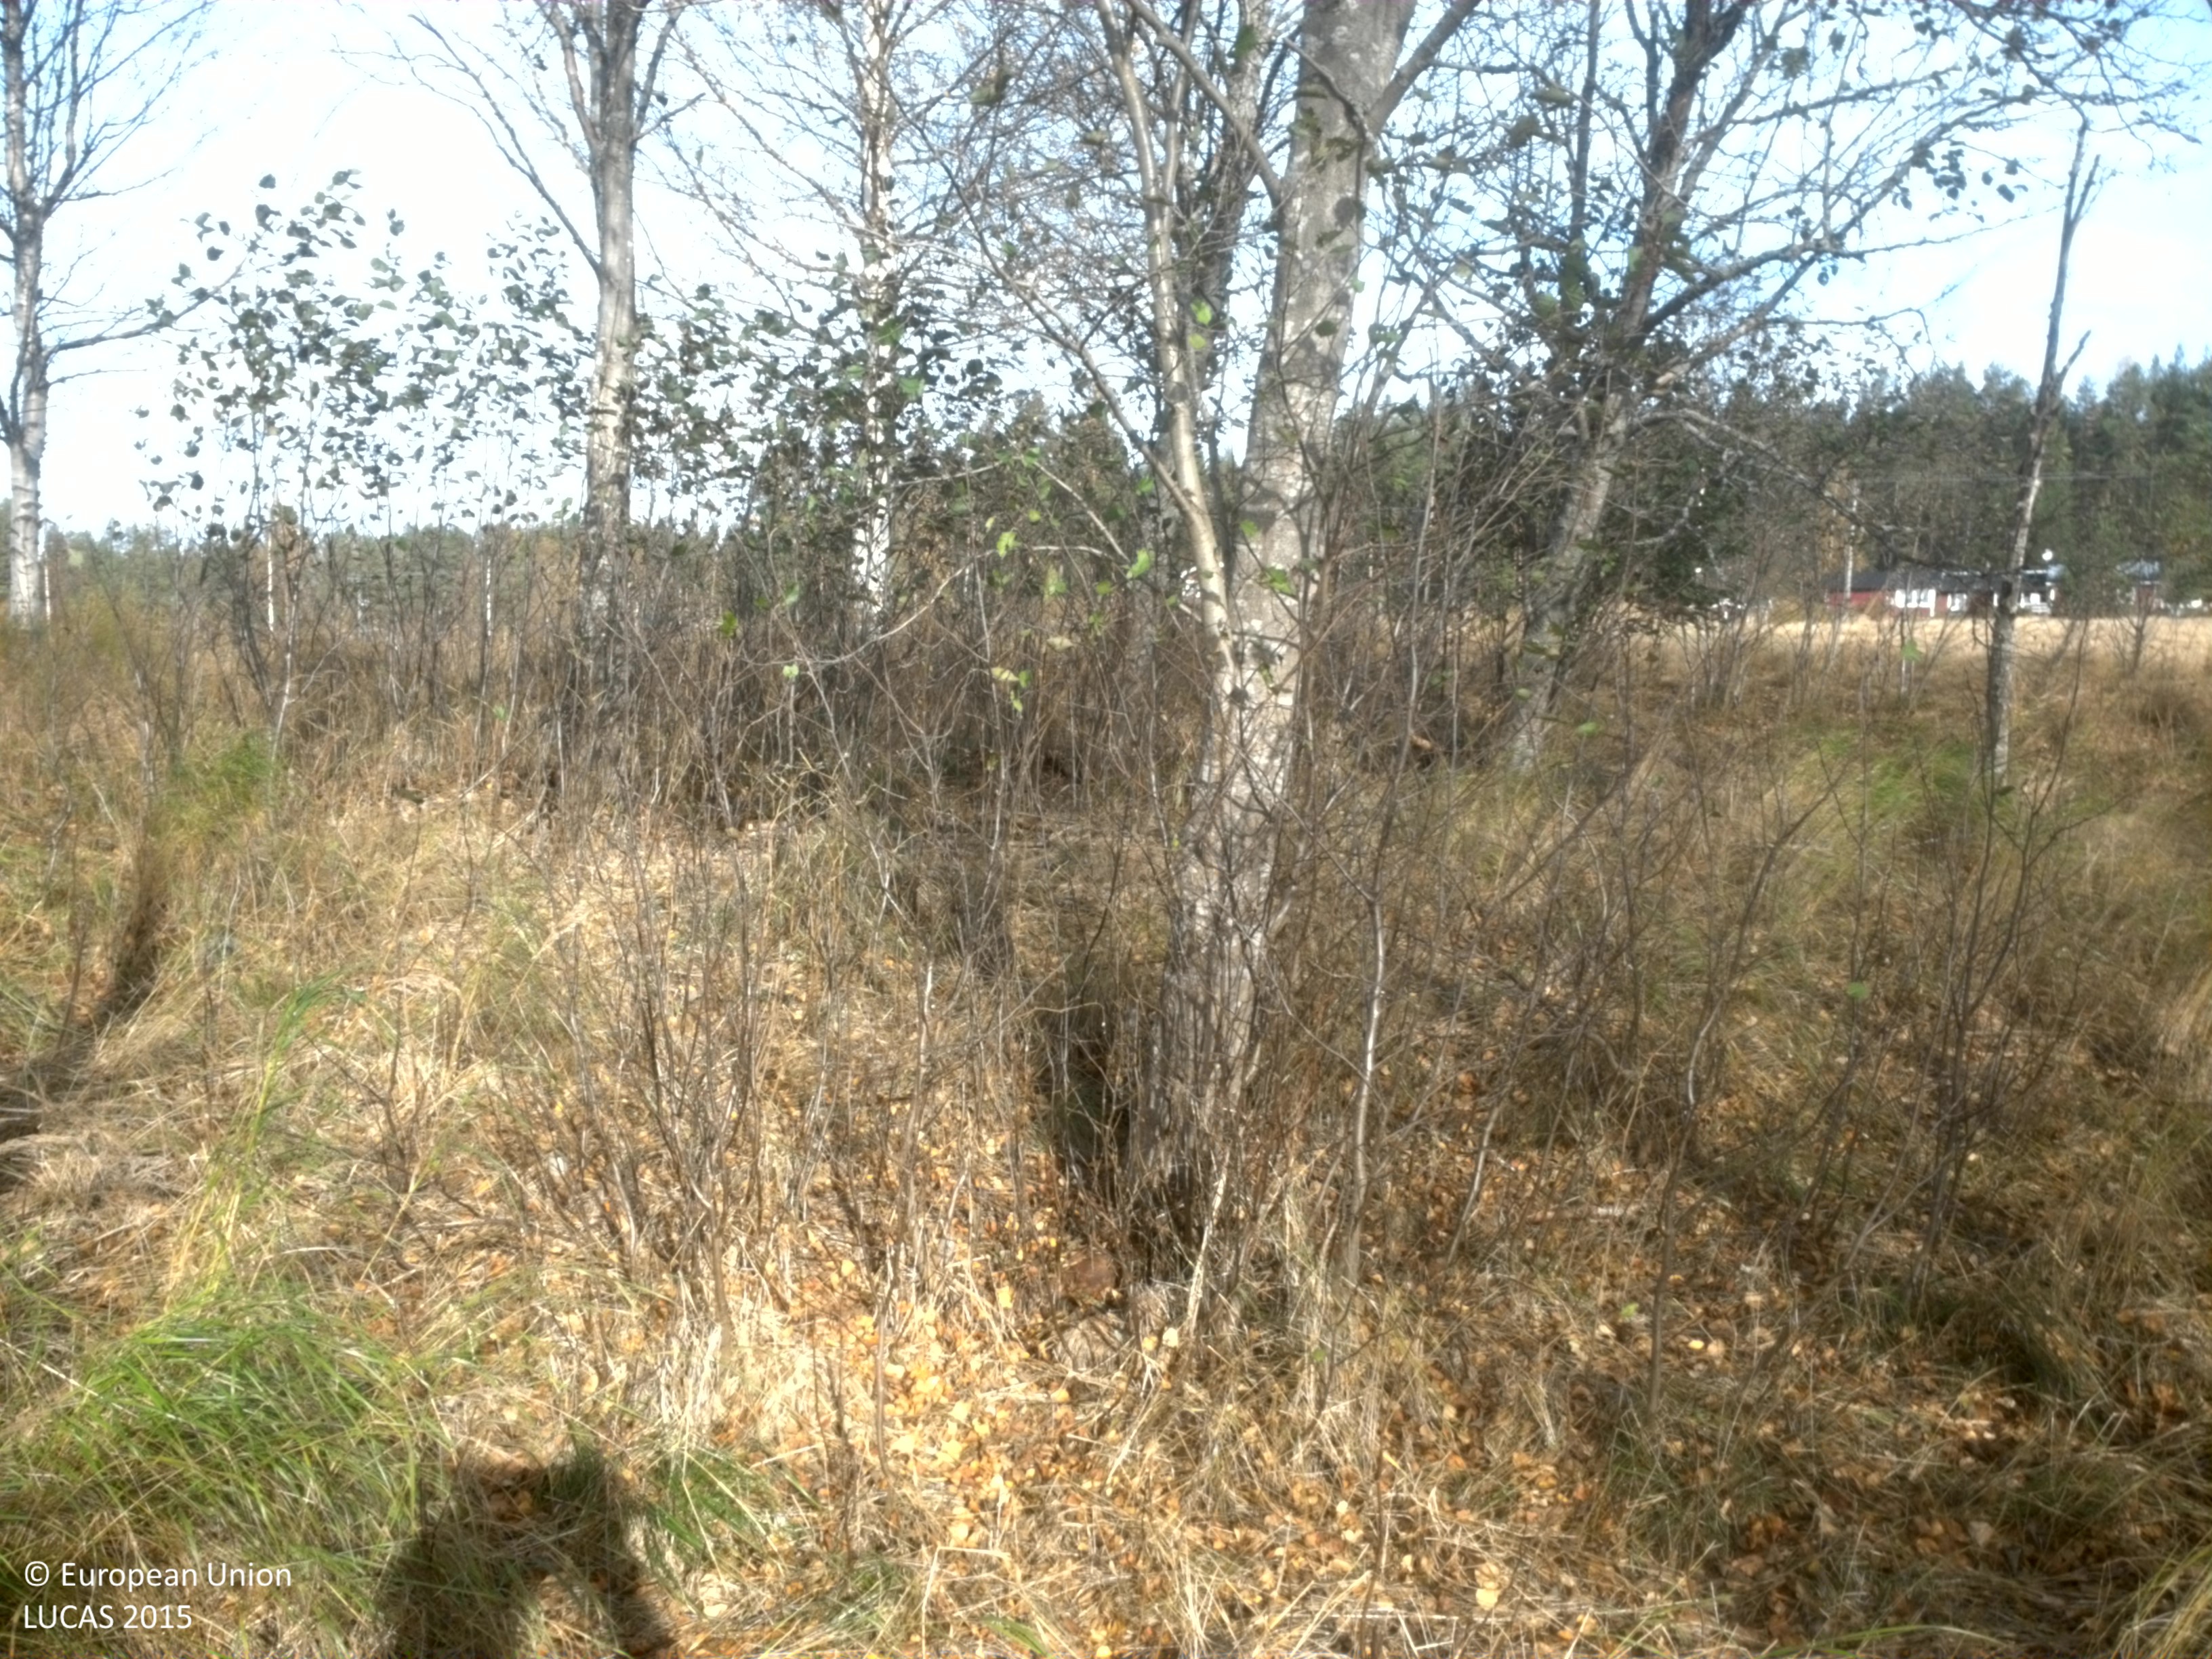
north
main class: Woodland
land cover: Broadleaved woodland
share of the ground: 25 - 50 %
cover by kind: herbaceous plants 60 %, broadleaved forest trees 40 %
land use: Semi-natural and natural areas not in use
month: October
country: SE
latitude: 64.0790
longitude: 20.0455
